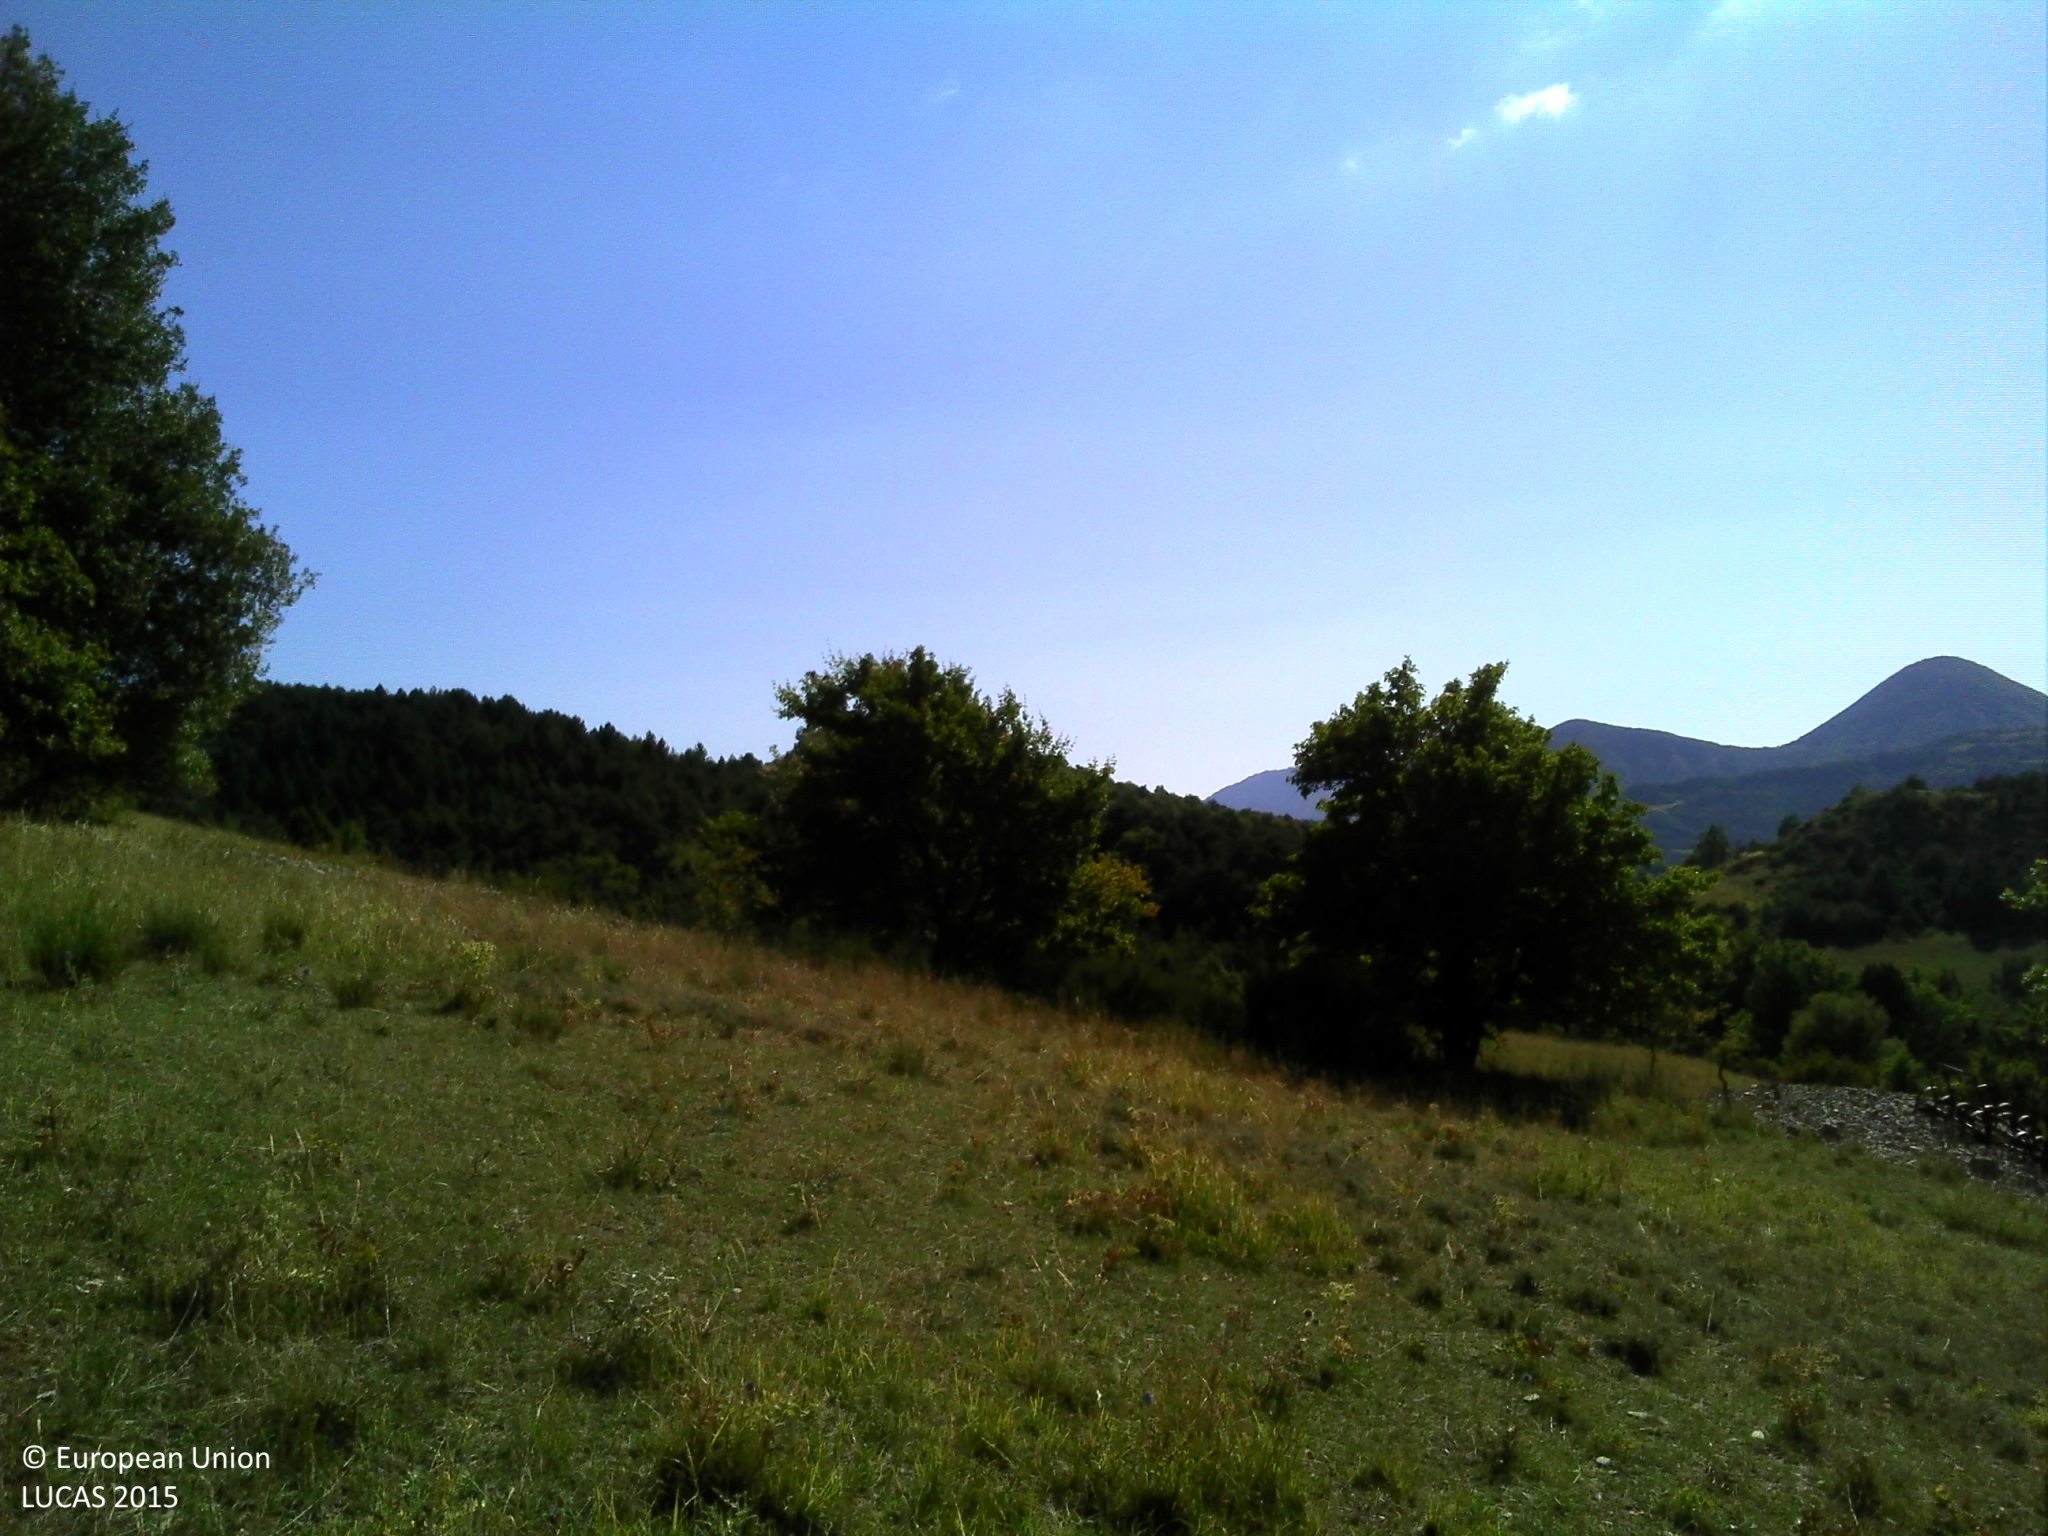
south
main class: Grassland
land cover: Grassland without tree/shrub cover
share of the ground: > 75 %
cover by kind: herbaceous plants 95 %, shrubs 5 %
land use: Agriculture (excluding fallow land and kitchen gardens)
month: September
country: FR
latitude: 44.5639
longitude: 5.1846
